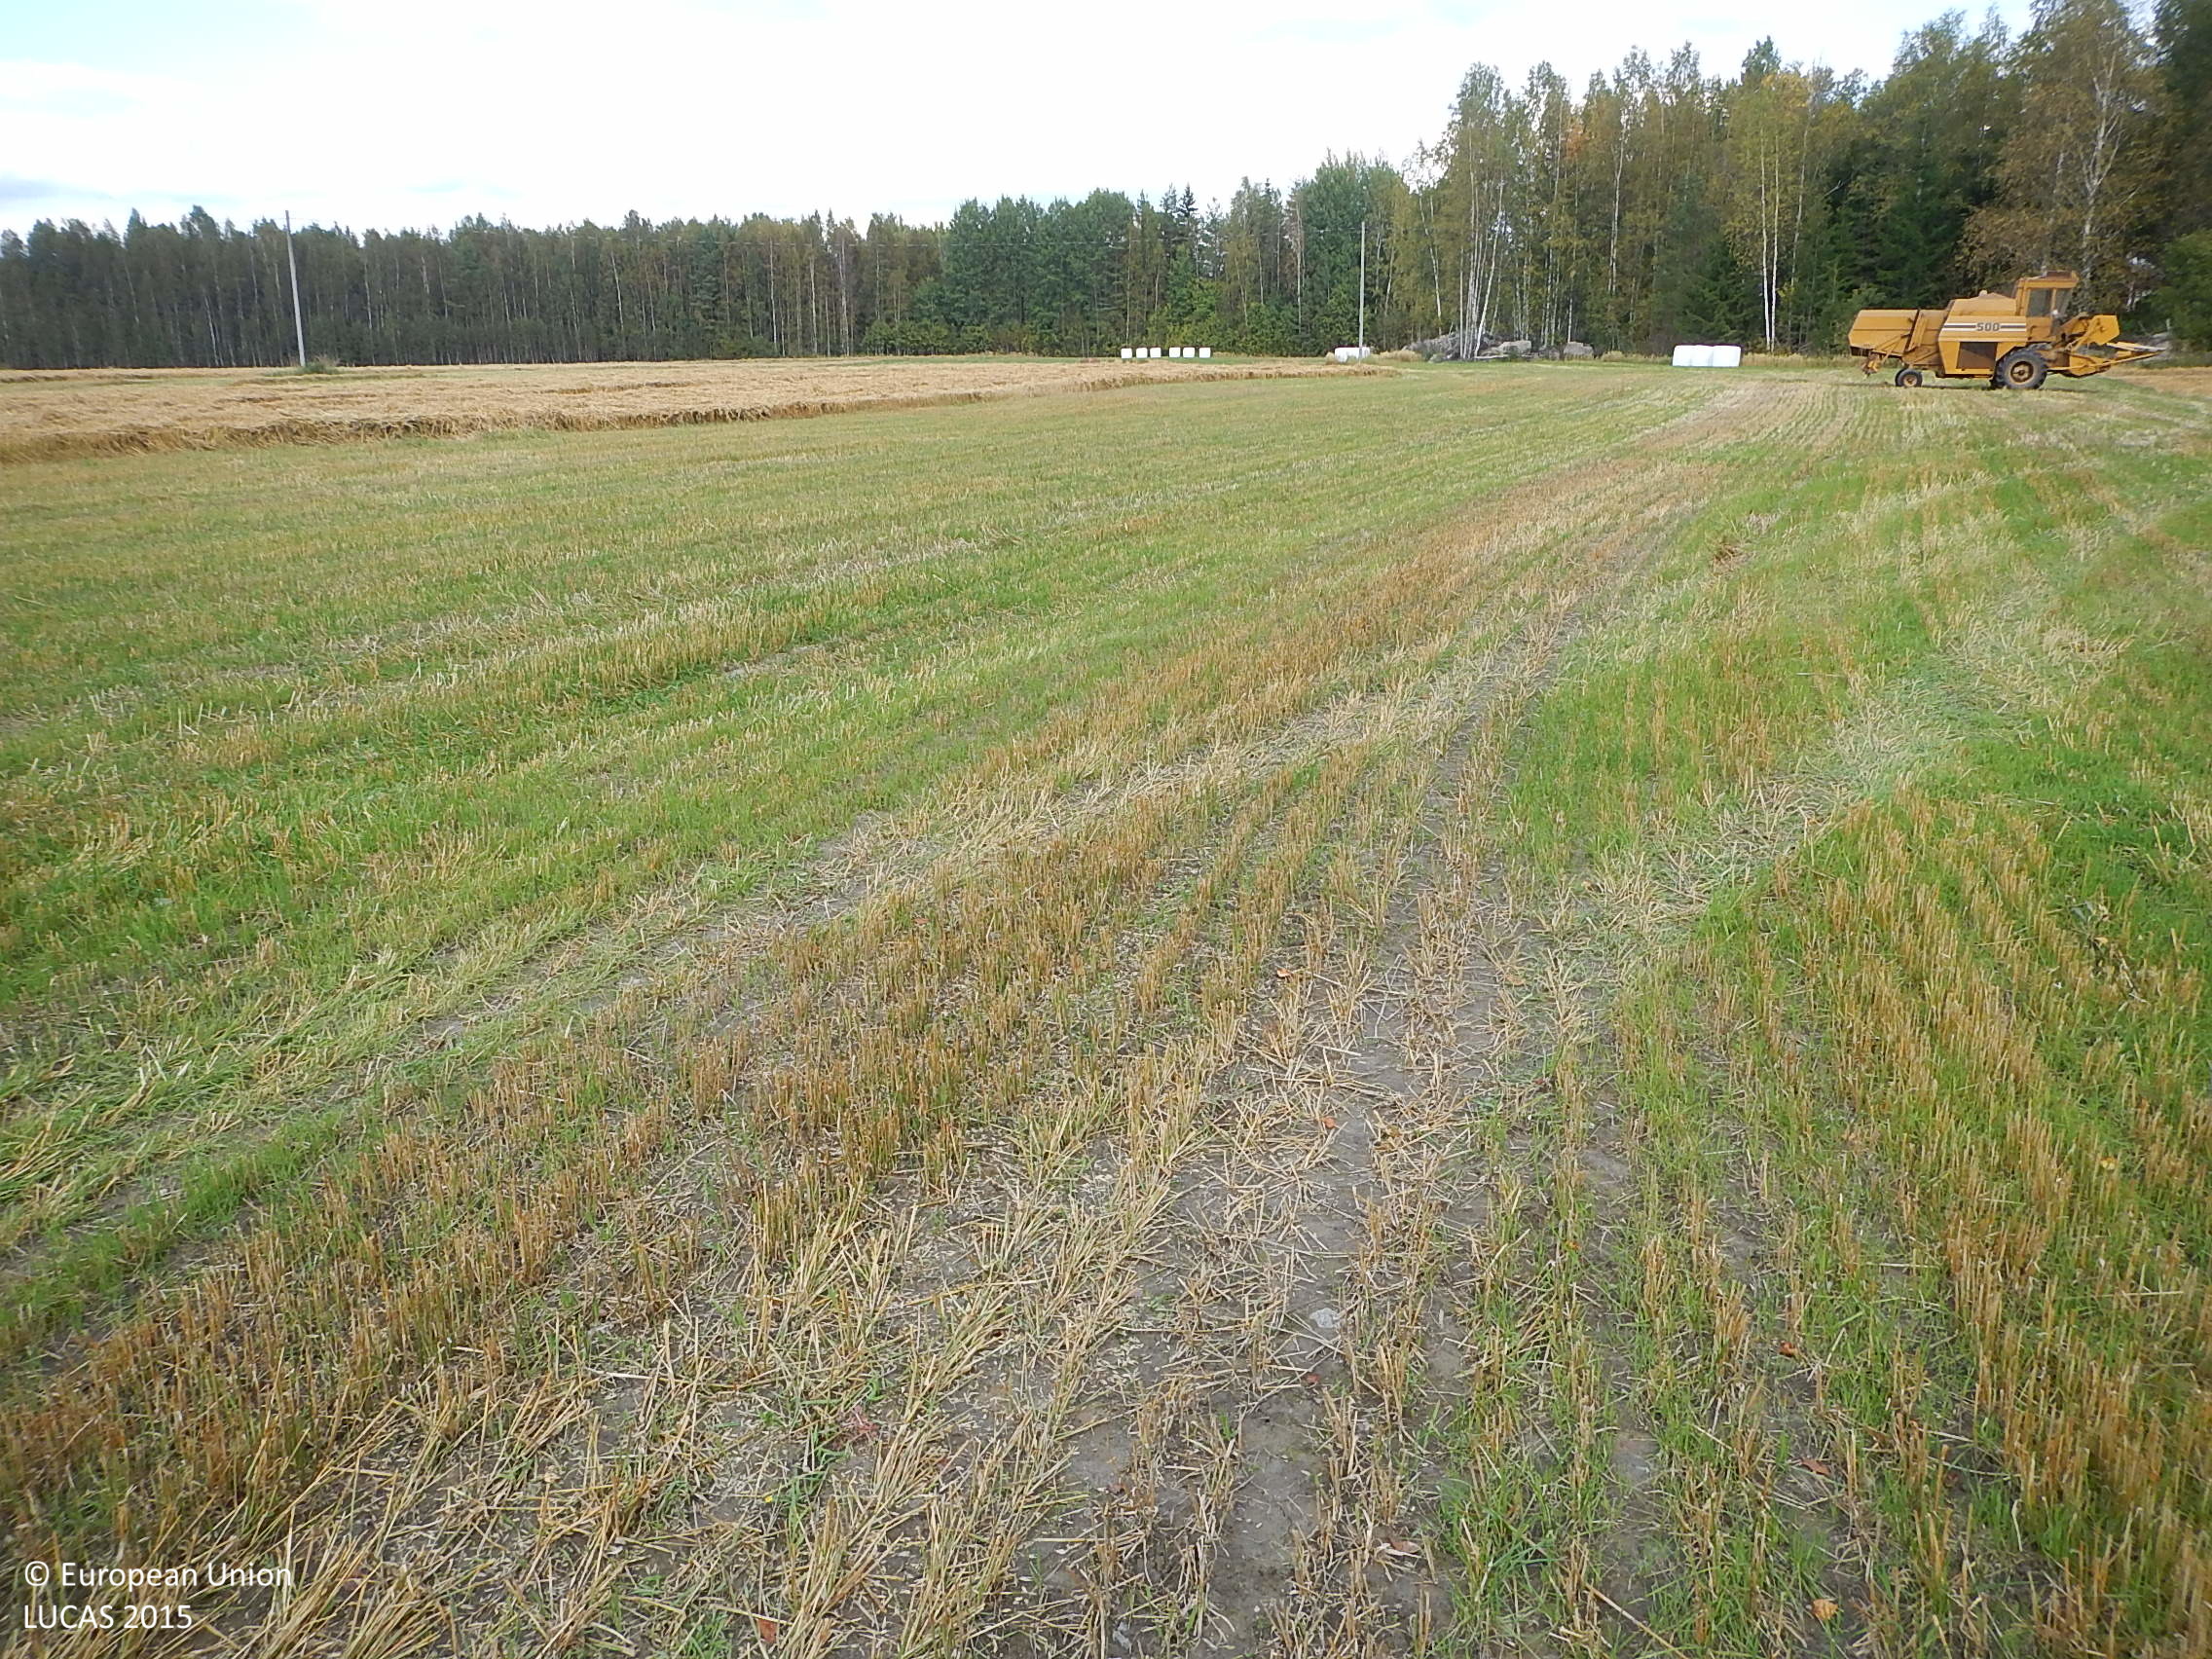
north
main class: Cropland
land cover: Oats
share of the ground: > 75 %
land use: Agriculture (excluding fallow land and kitchen gardens)
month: September
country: FI
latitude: 61.6094
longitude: 22.3335
